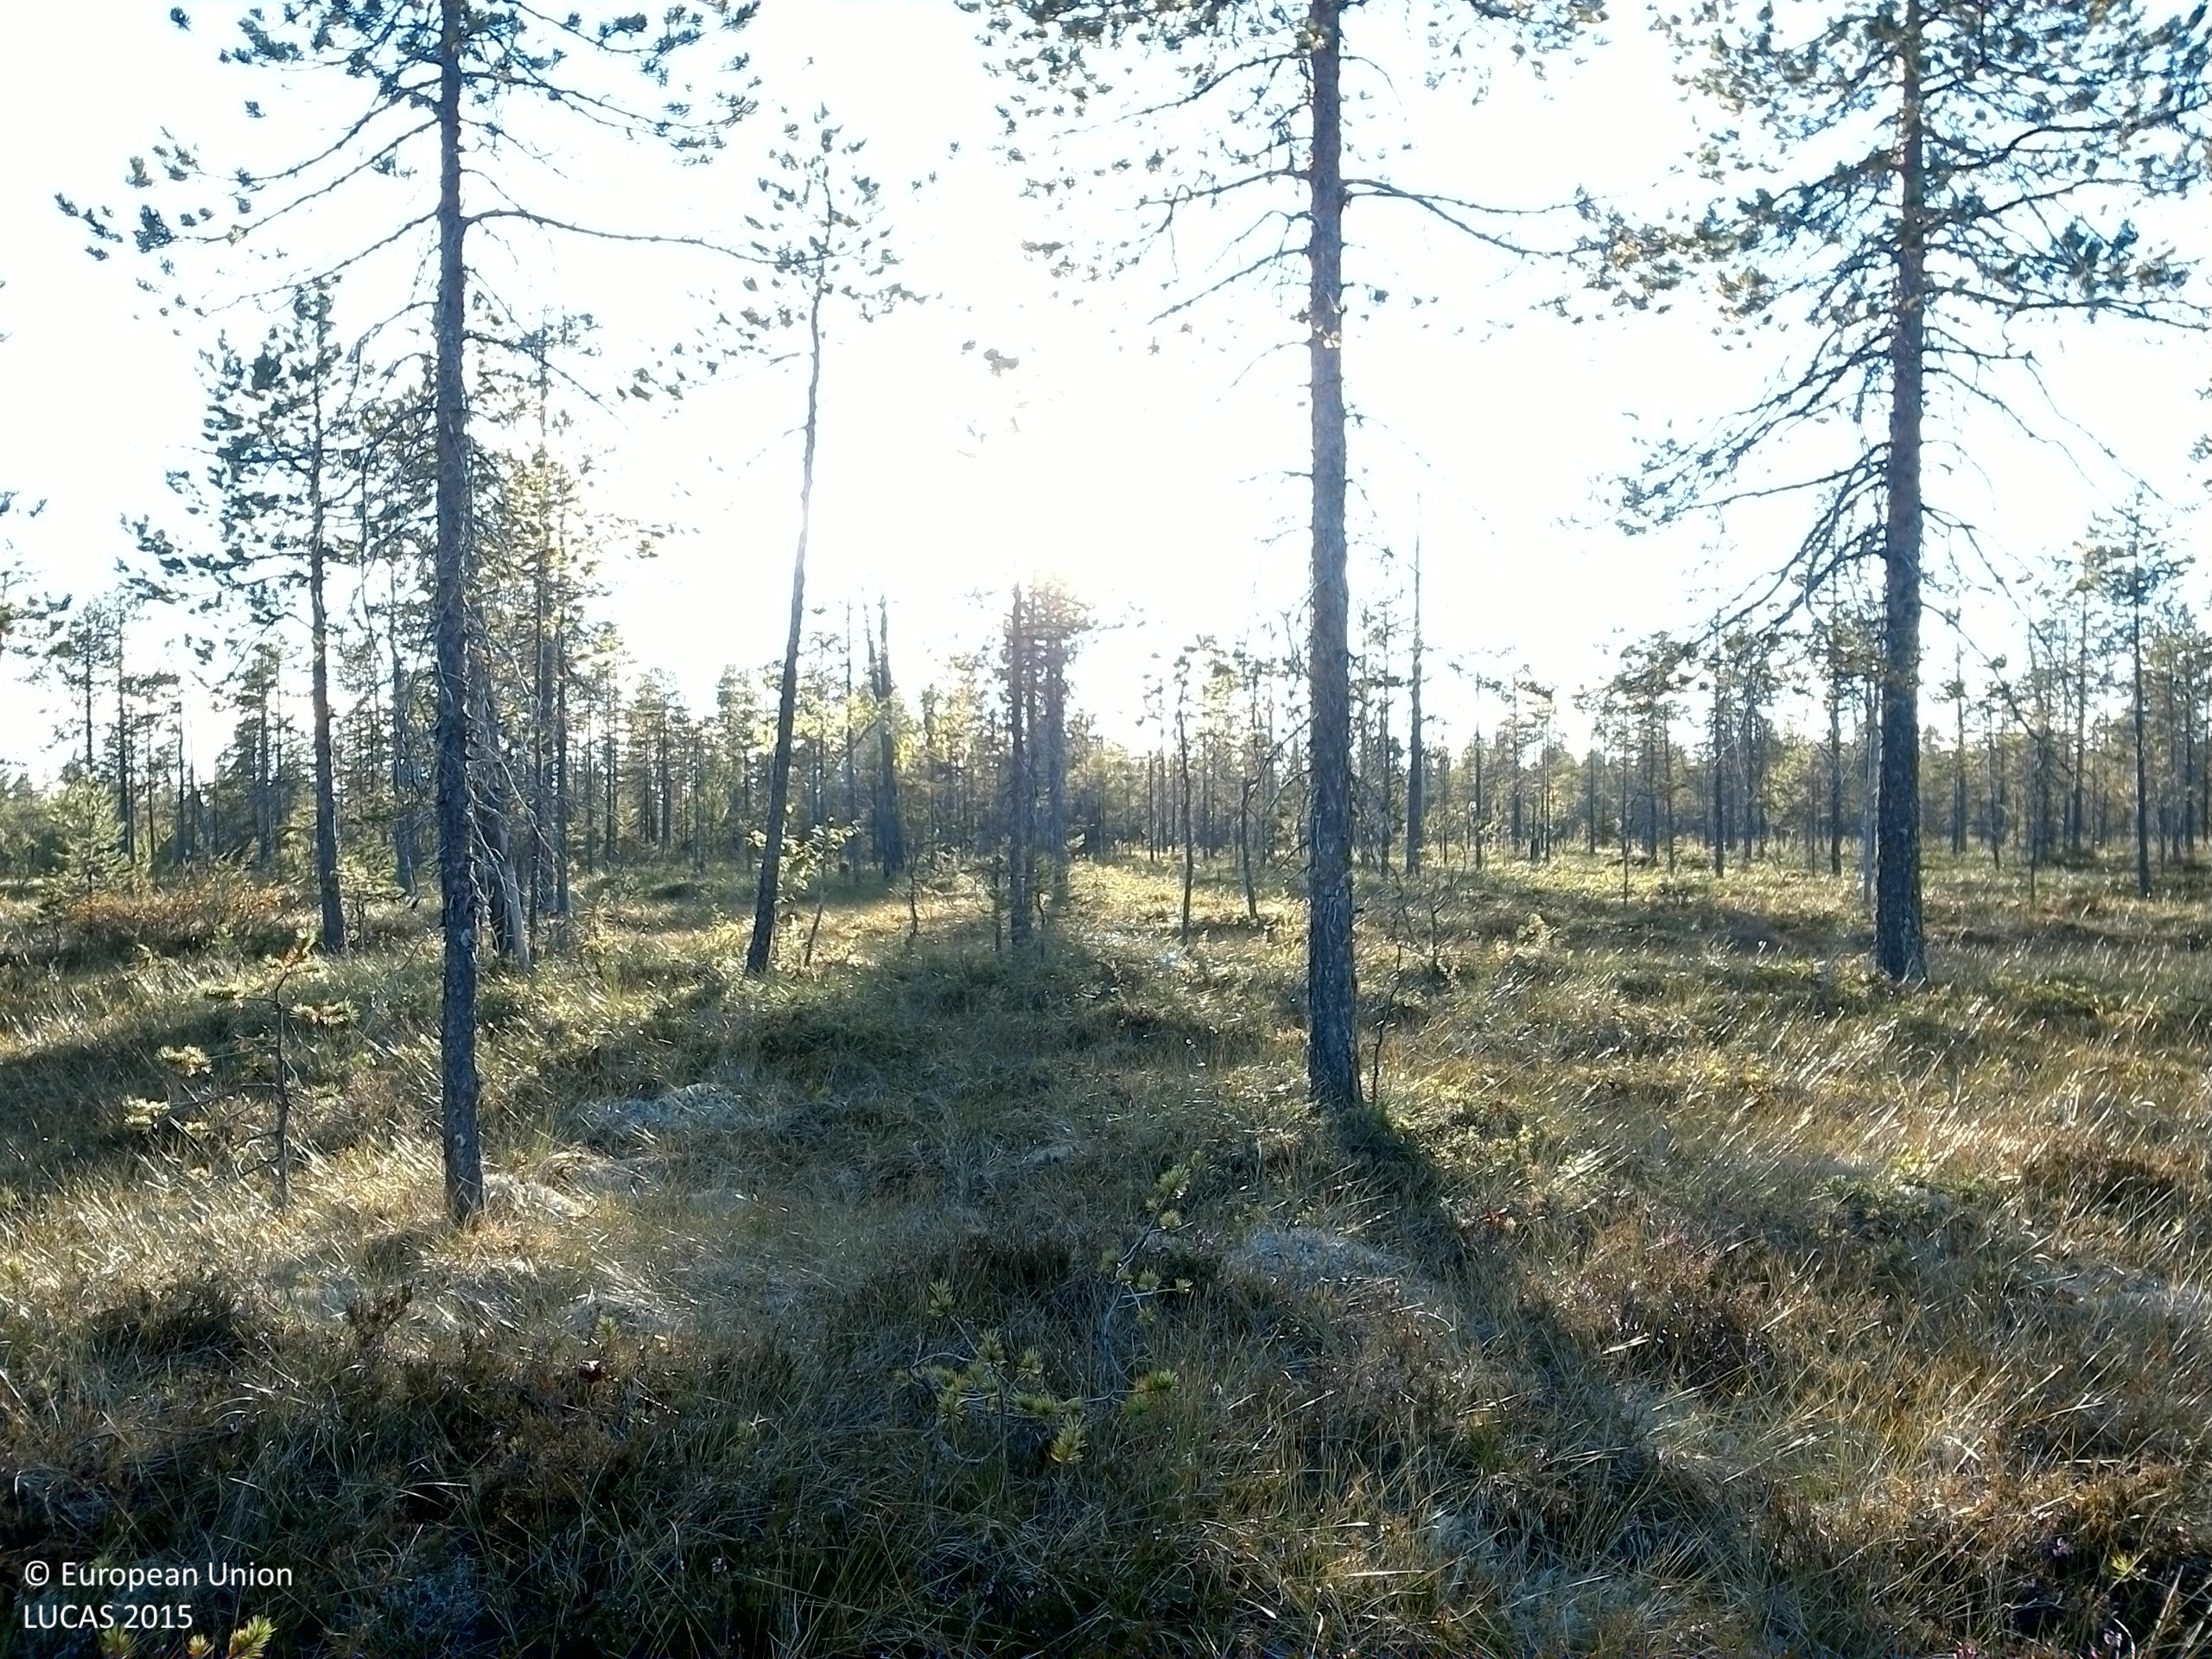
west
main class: Woodland
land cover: Pine dominated coniferous woodland
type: boreal forest
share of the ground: 10 - 25 %
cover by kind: shrubs 50 %, lichens and mosses 25 %, coniferous forest trees 15 %, herbaceous plants 10 %
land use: Semi-natural and natural areas not in use
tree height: < 5 m
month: August
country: SE
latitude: 63.6857
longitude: 18.0410
